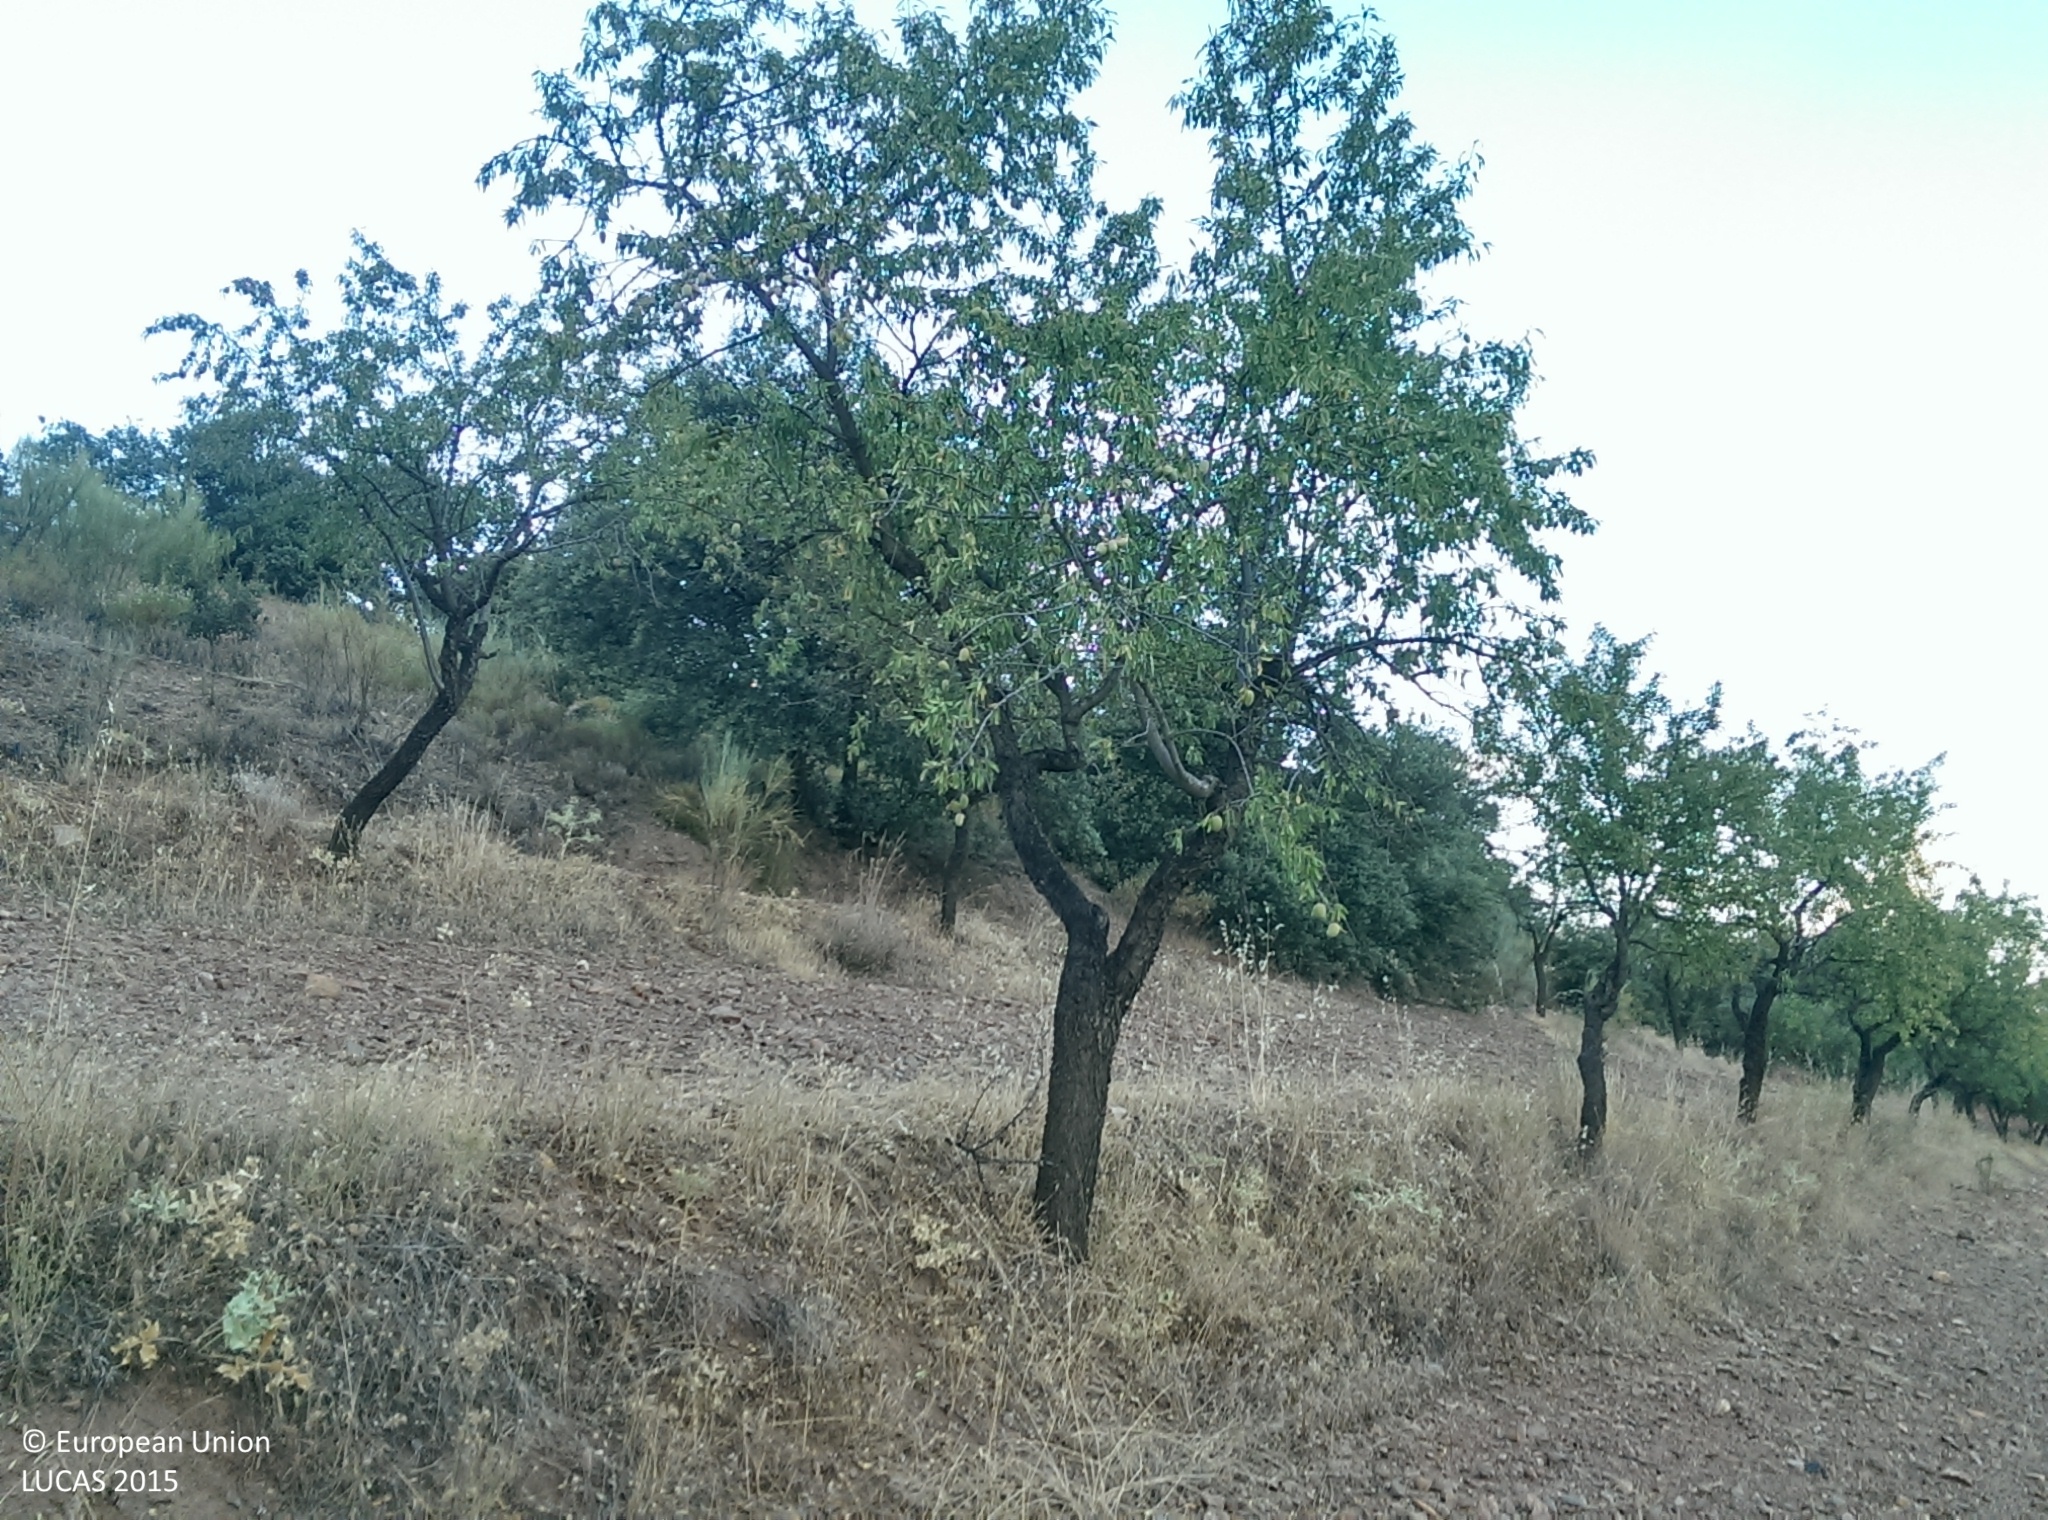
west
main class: Cropland
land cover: Nuts trees
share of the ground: 25 - 50 %
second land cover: Other bare soil
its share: > 75 %
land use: Agriculture (excluding fallow land and kitchen gardens)
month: July
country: ES
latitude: 37.2731
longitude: -3.2613
